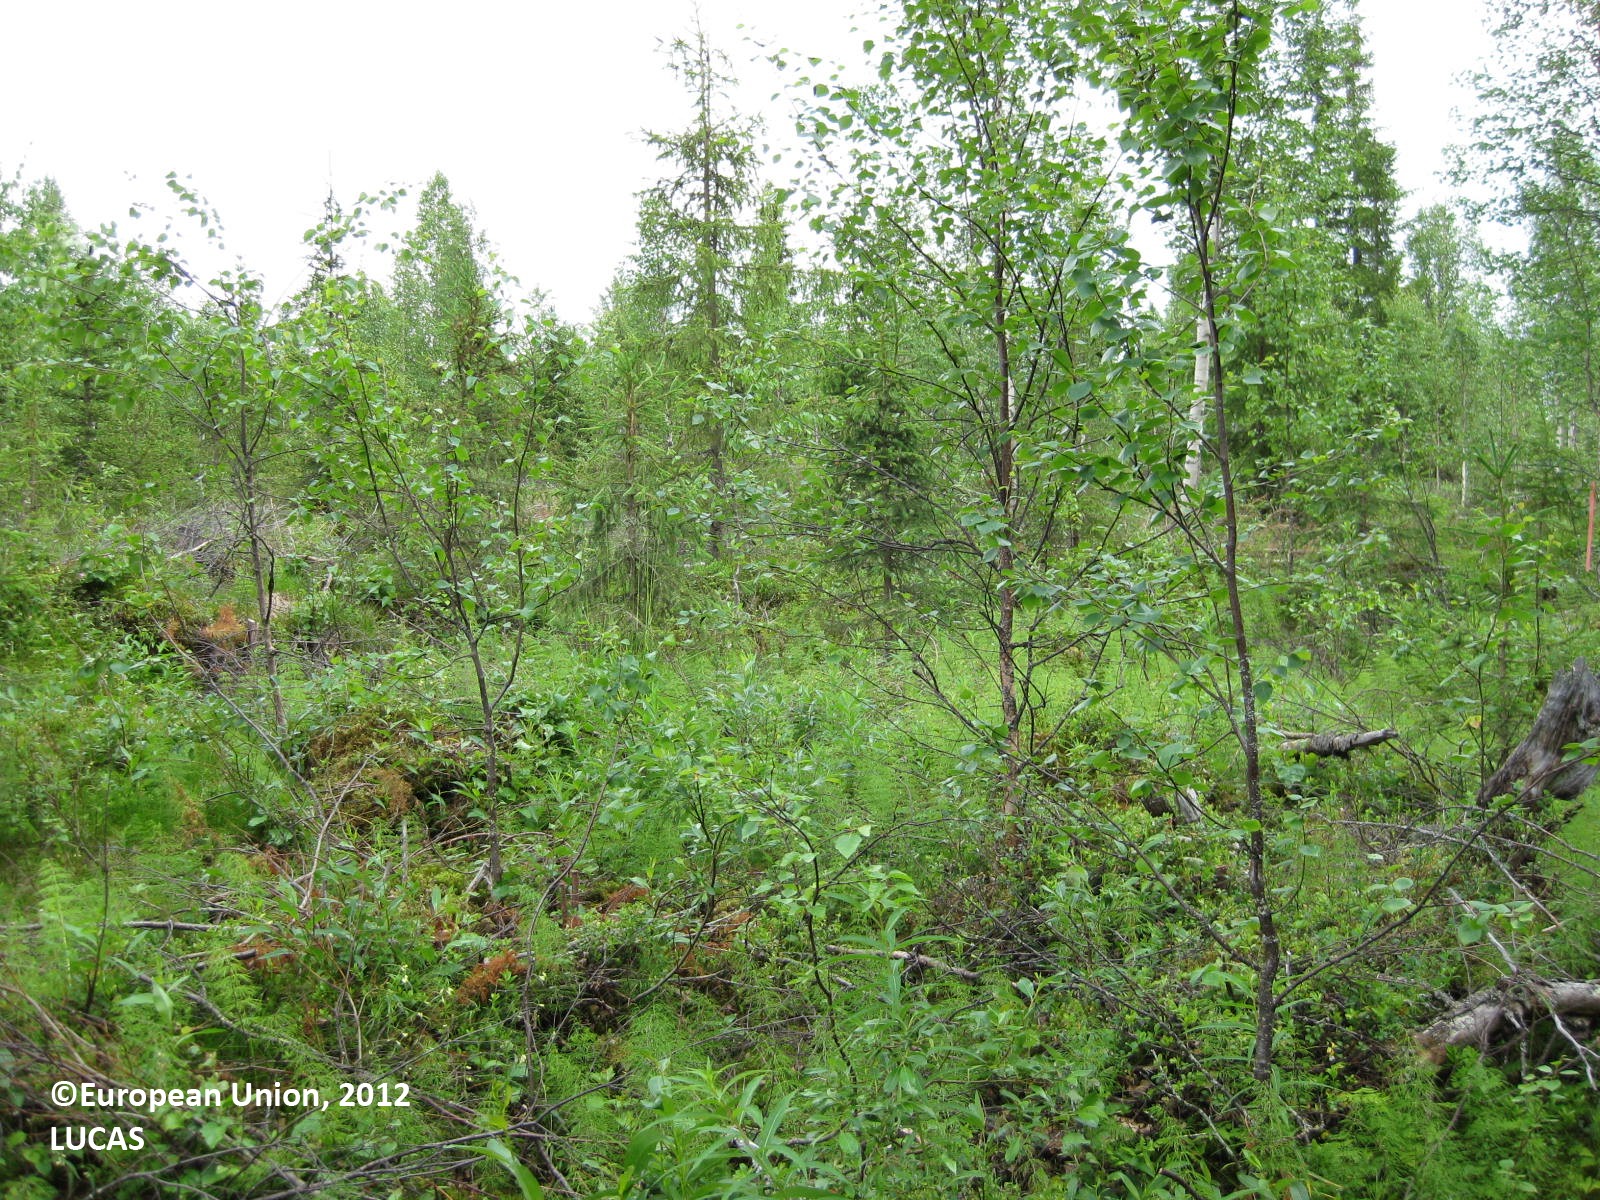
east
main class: Woodland
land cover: Spruce dominated mixed woodland
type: boreal forest
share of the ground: 50 - 75 %
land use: Forestry
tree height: < 5 m
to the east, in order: Ditches and canals; Spruce dominated mixed woodland; Ditches and canals; Spruce dominated mixed woodland; Ditches and canals; Spruce dominated mixed woodland; Ditches and canals; Spruce dominated mixed woodland; Ditches and canals; Spruce dominated mixed woodland; Ditches and canals; Spruce dominated mixed woodland; Ditches and canals; Spruce dominated mixed woodland; Ditches and canals; Spruce dominated mixed woodland; Ditches and canals; Spruce dominated mixed woodland; Ditches and canals; Spruce dominated mixed woodland; Ditches and canals; Spruce dominated mixed woodland; Ditches and canals; Spruce dominated mixed woodland; Ditches and canals; Spruce dominated mixed woodland; Ditches and canals; Spruce dominated mixed woodland; Ditches and canals; Spruce dominated mixed woodland; Ditches and canals; Spruce dominated mixed woodland; Ditches and canals; Spruce dominated mixed woodland; Ditches and canals; Spruce dominated mixed woodland; Ditches and canals; Spruce dominated mixed woodland; Ditches and canals; Spruce dominated mixed woodland; Ditches and canals; Spruce dominated mixed woodland; Ditches and canals; Spruce dominated mixed woodland; Ditches and canals; Spruce dominated mixed woodland; Ditches and canals; Spruce dominated mixed woodland; Ditches and canals; Spruce dominated mixed woodland; Ditches and canals; Spruce dominated mixed woodland
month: July
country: FI
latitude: 65.5617
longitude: 28.2847
